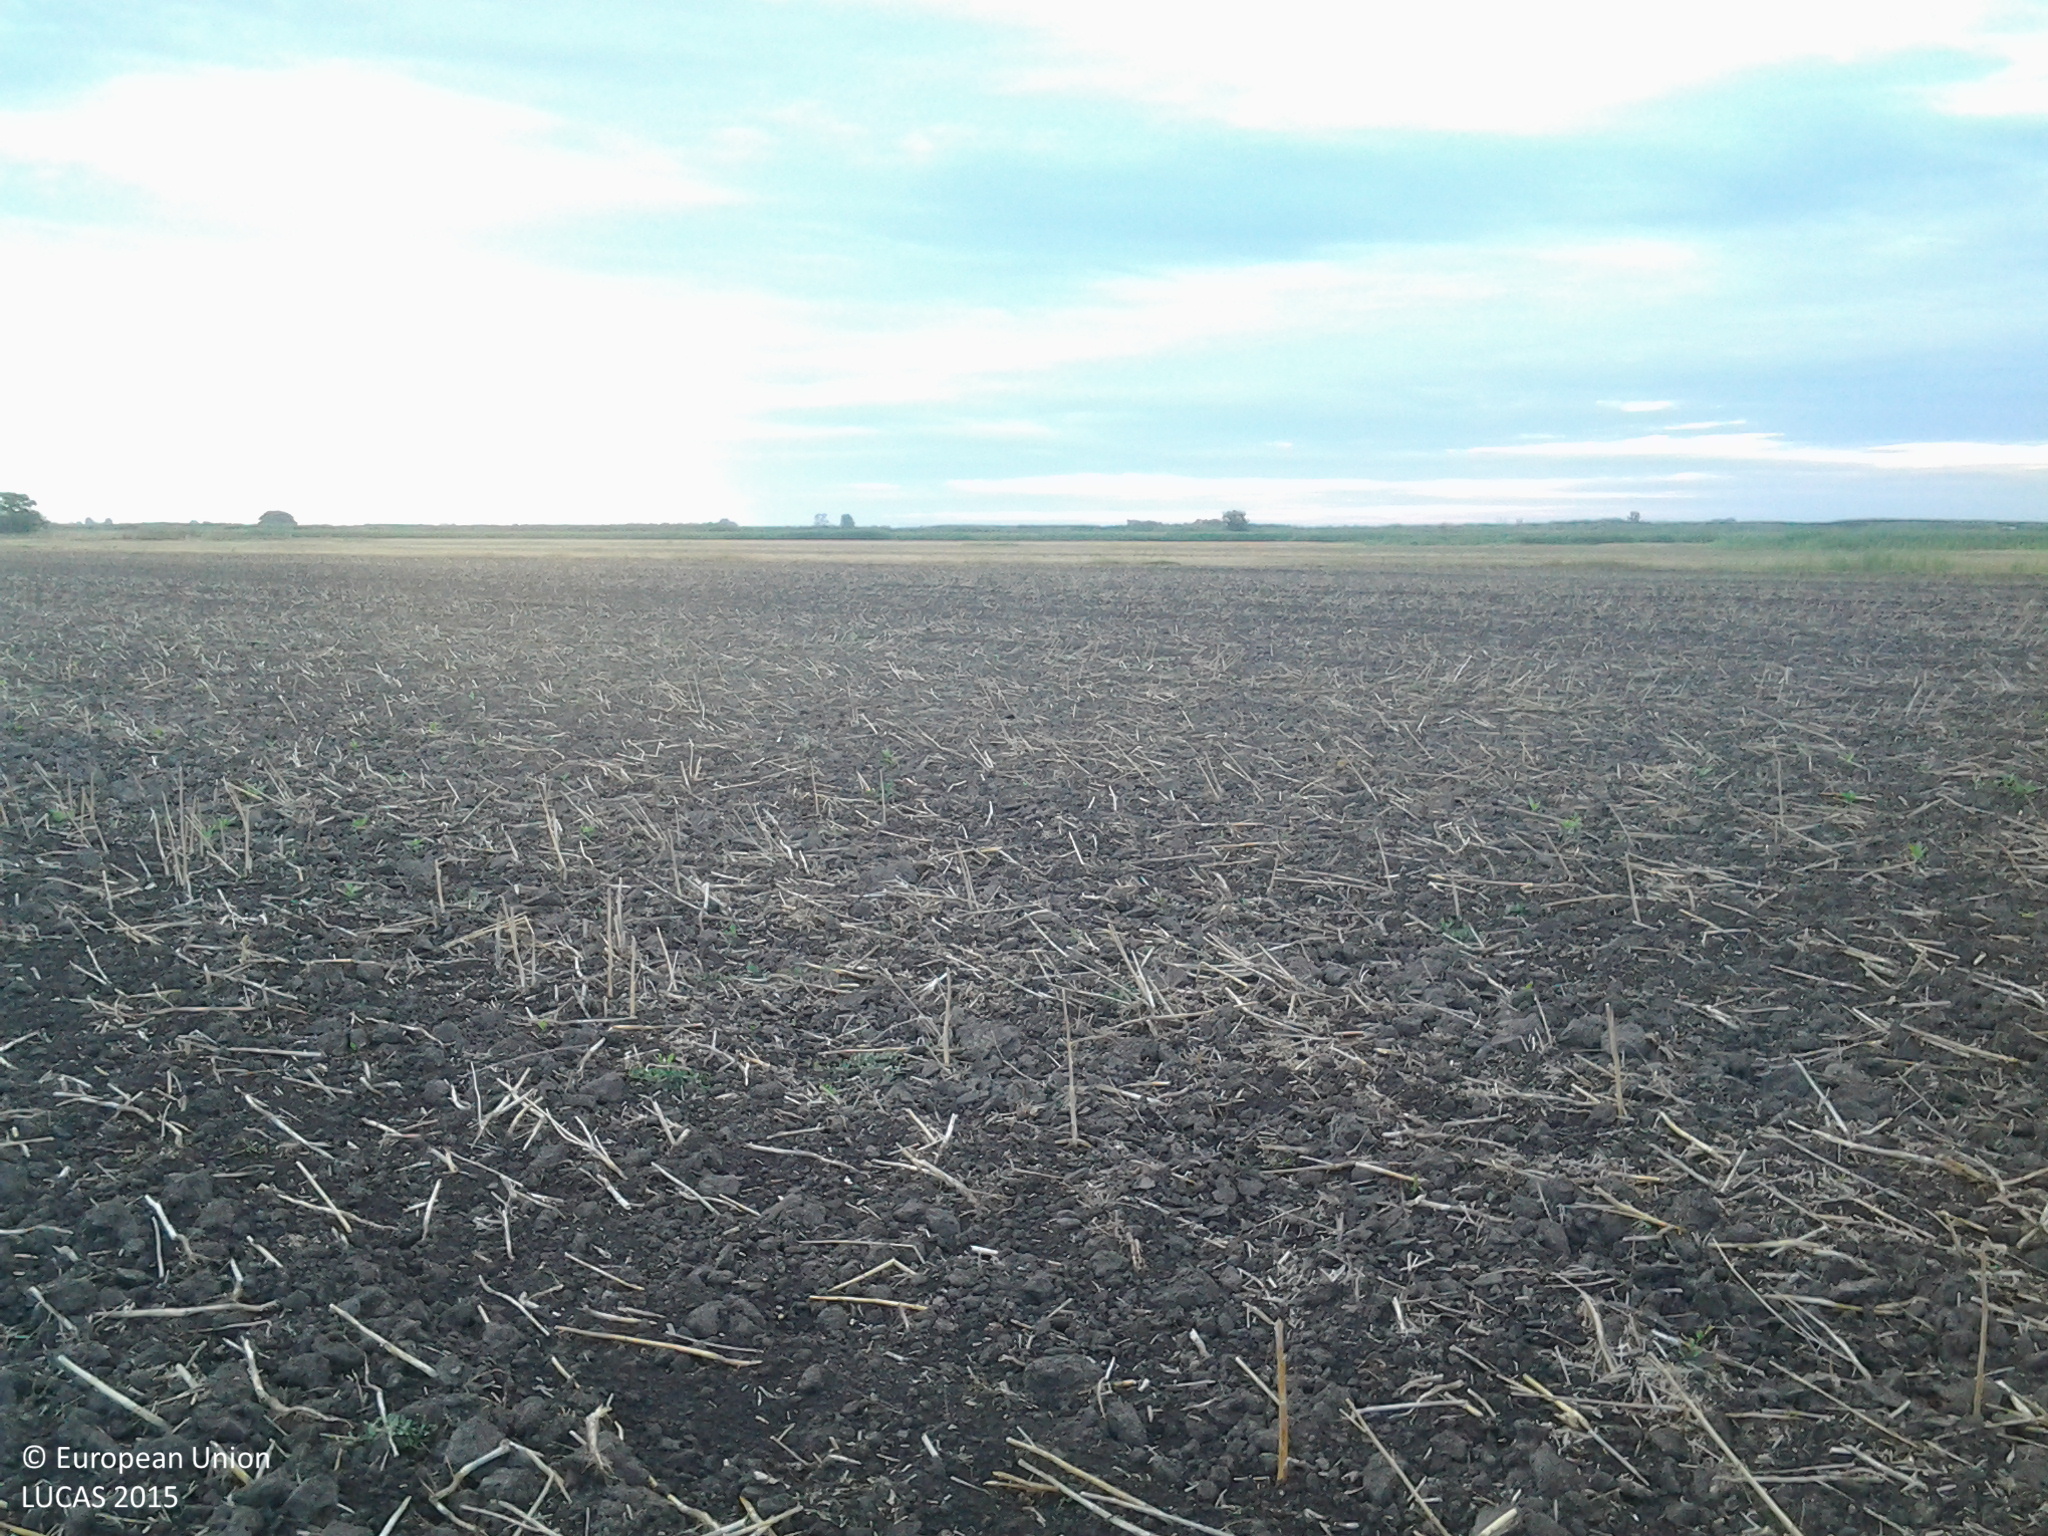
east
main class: Cropland
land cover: Rape and turnip rape
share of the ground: < 10 %
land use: Agriculture (excluding fallow land and kitchen gardens)
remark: Harvested field
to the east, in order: Rape and turnip rape; Grassland without tree/shrub cover
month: July
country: HU
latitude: 46.9794
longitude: 19.0737
